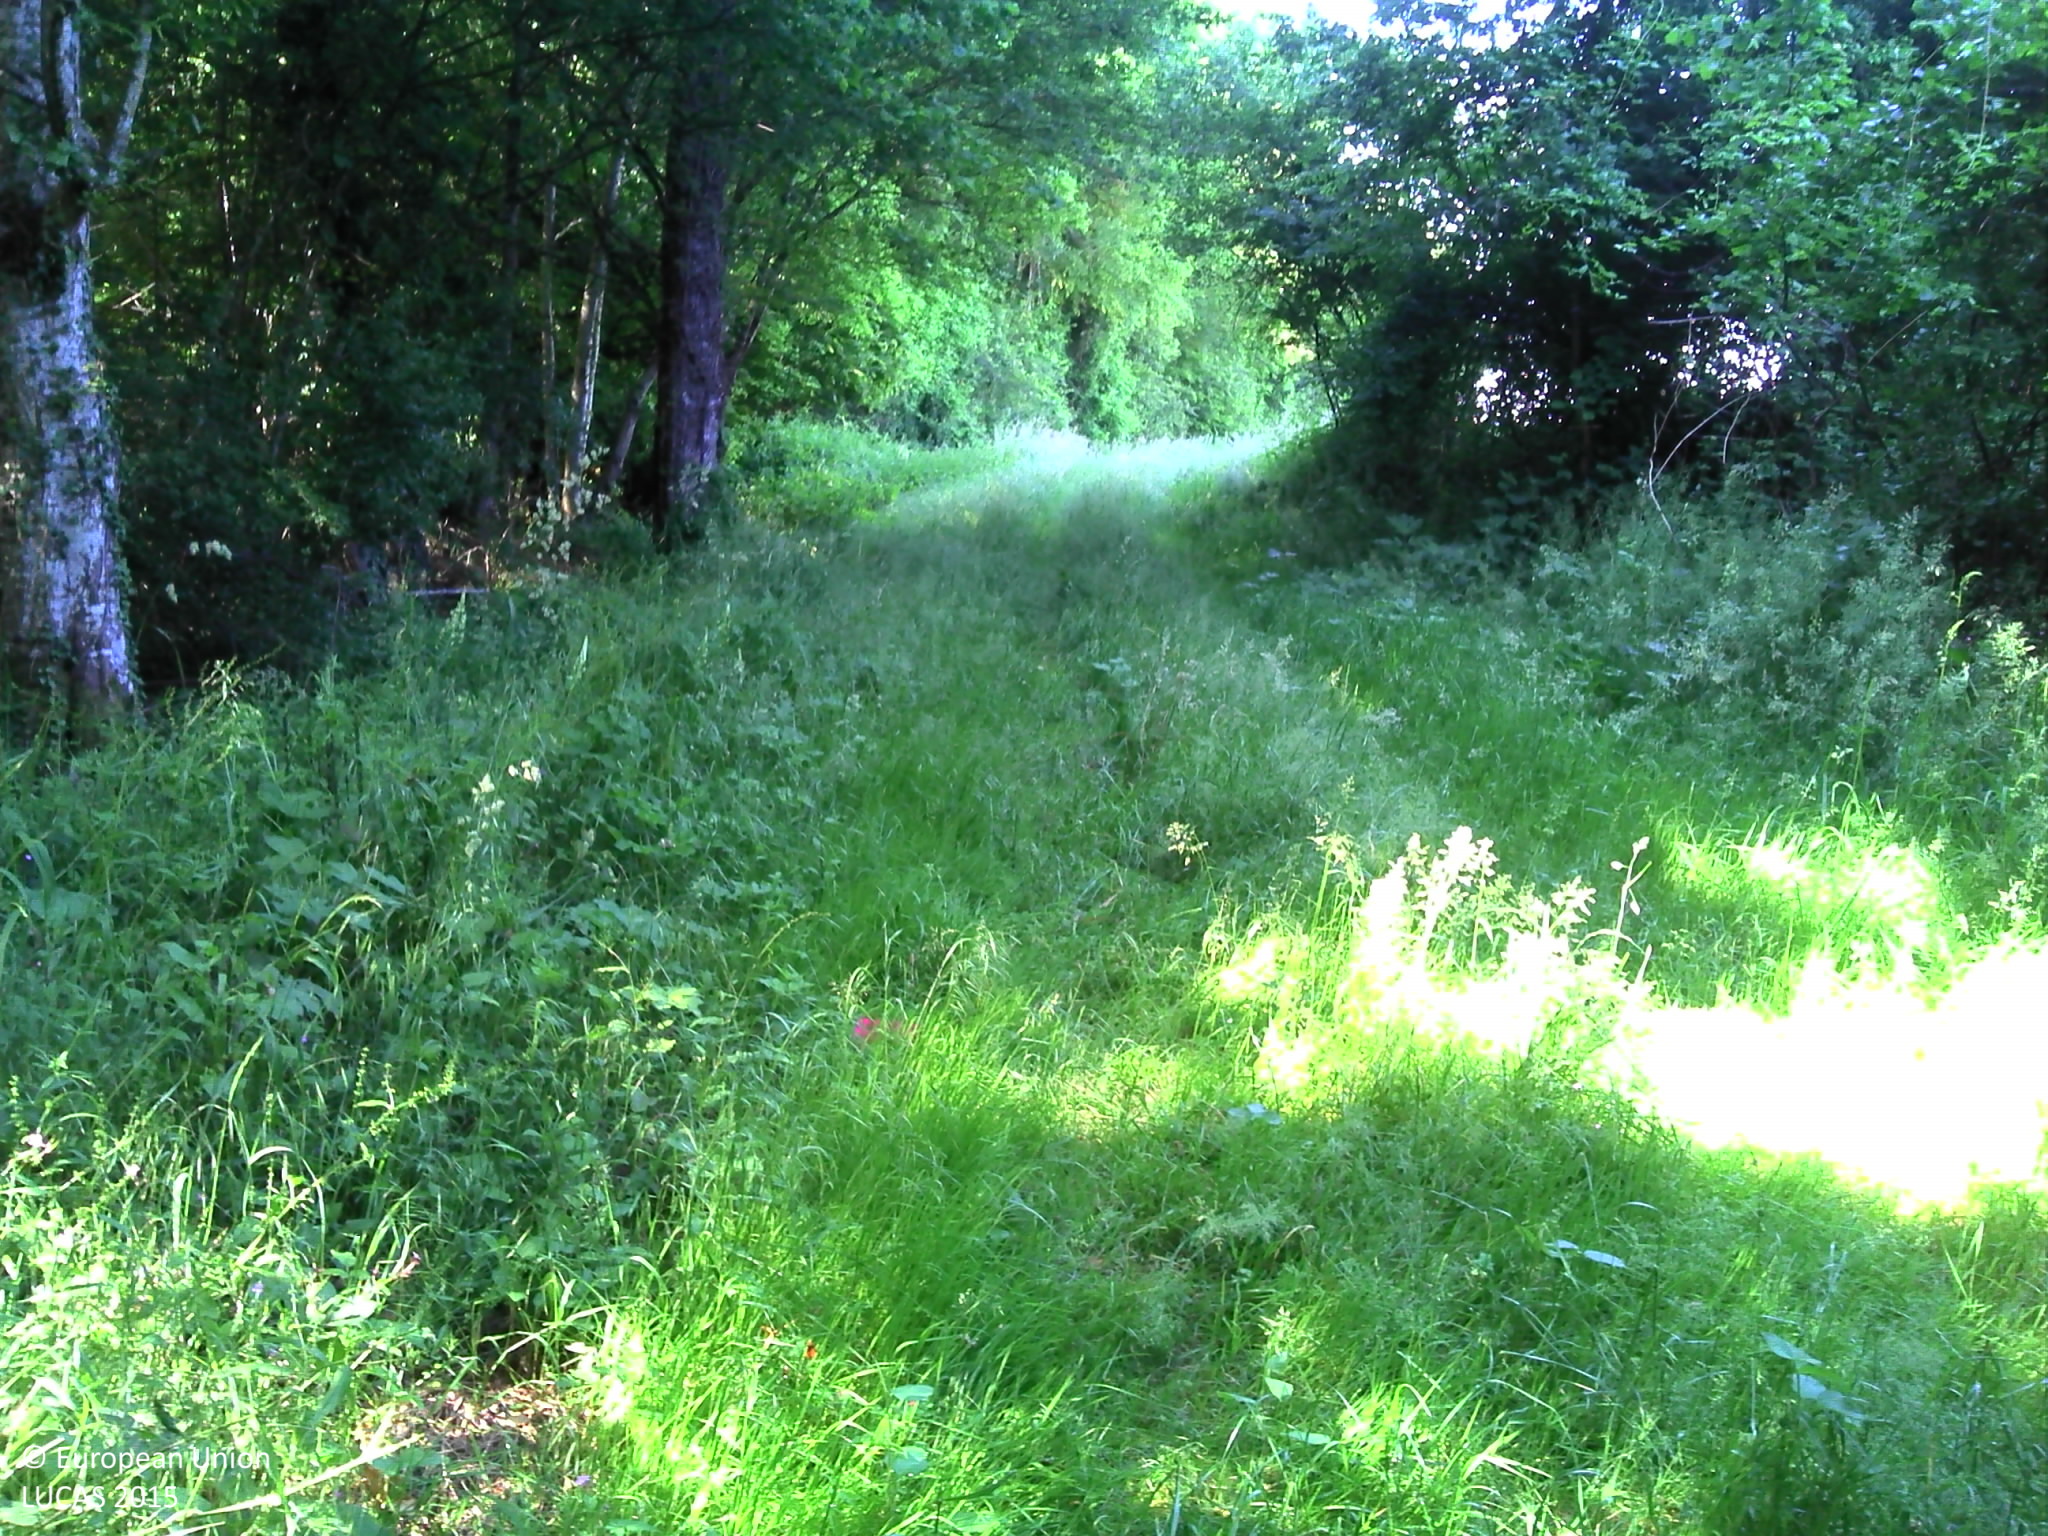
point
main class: Woodland
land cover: Broadleaved woodland
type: mesophytic deciduous forest
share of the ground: > 75 %
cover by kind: broadleaved forest trees 85 %, herbaceous plants 15 %
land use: Forestry
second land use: Amenities, museums, leisure
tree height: > 5 m
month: June
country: FR
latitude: 47.1749
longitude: 5.0530
